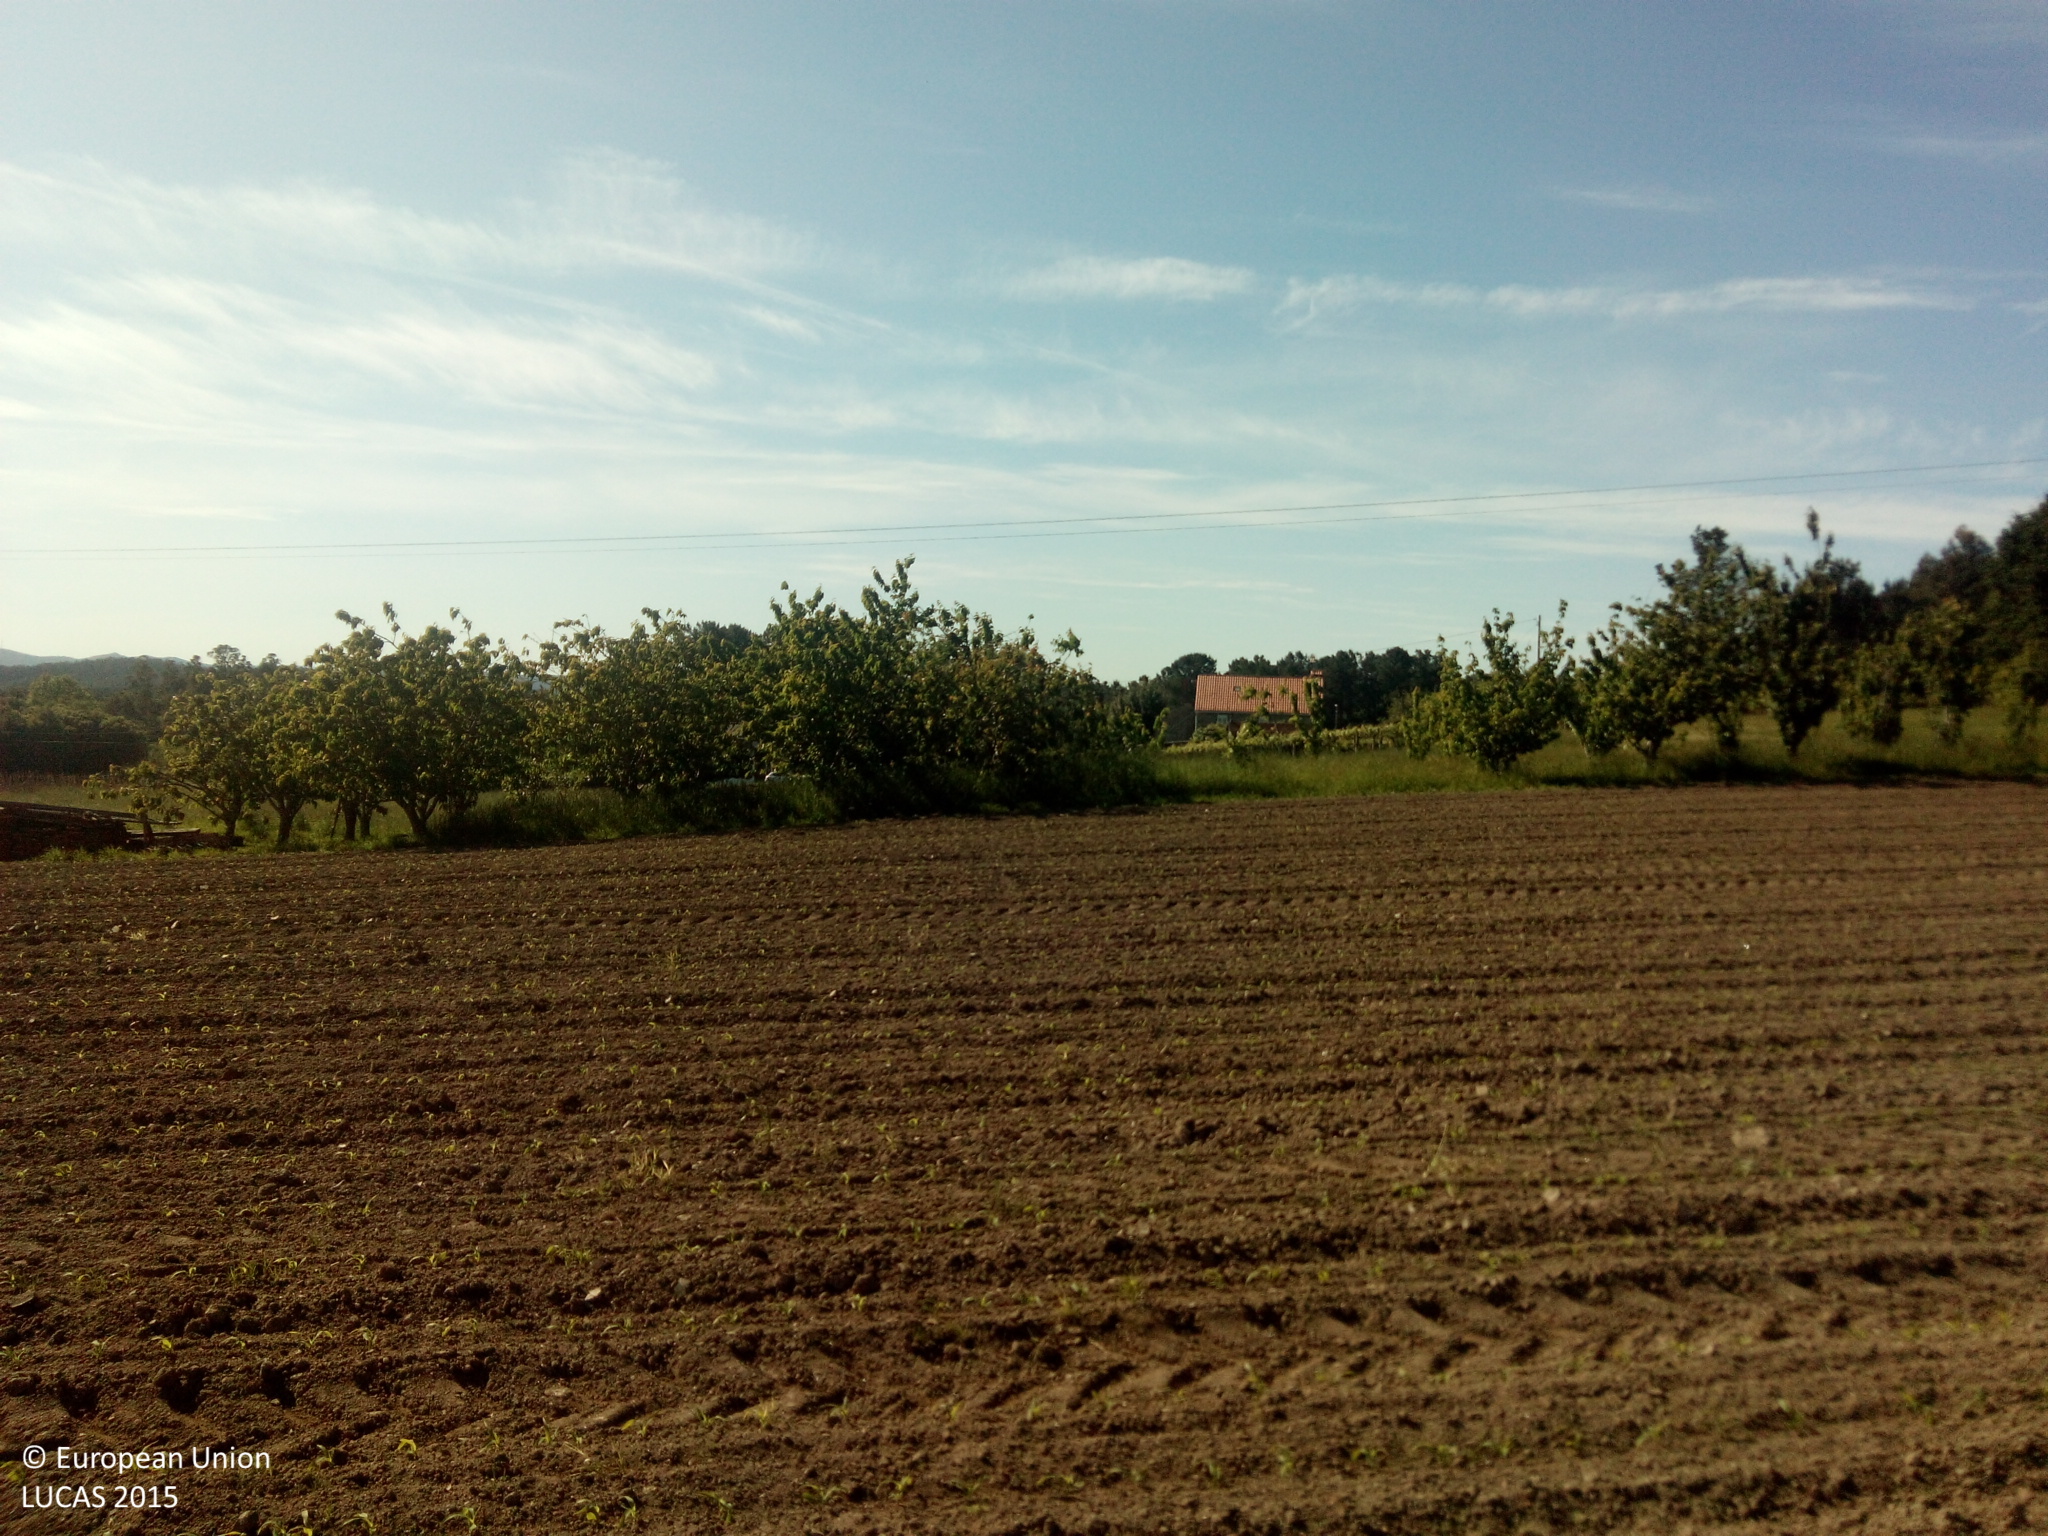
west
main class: Cropland
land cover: Maize
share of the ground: > 75 %
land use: Agriculture (excluding fallow land and kitchen gardens)
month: May
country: ES
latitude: 42.7149
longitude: -8.4519
